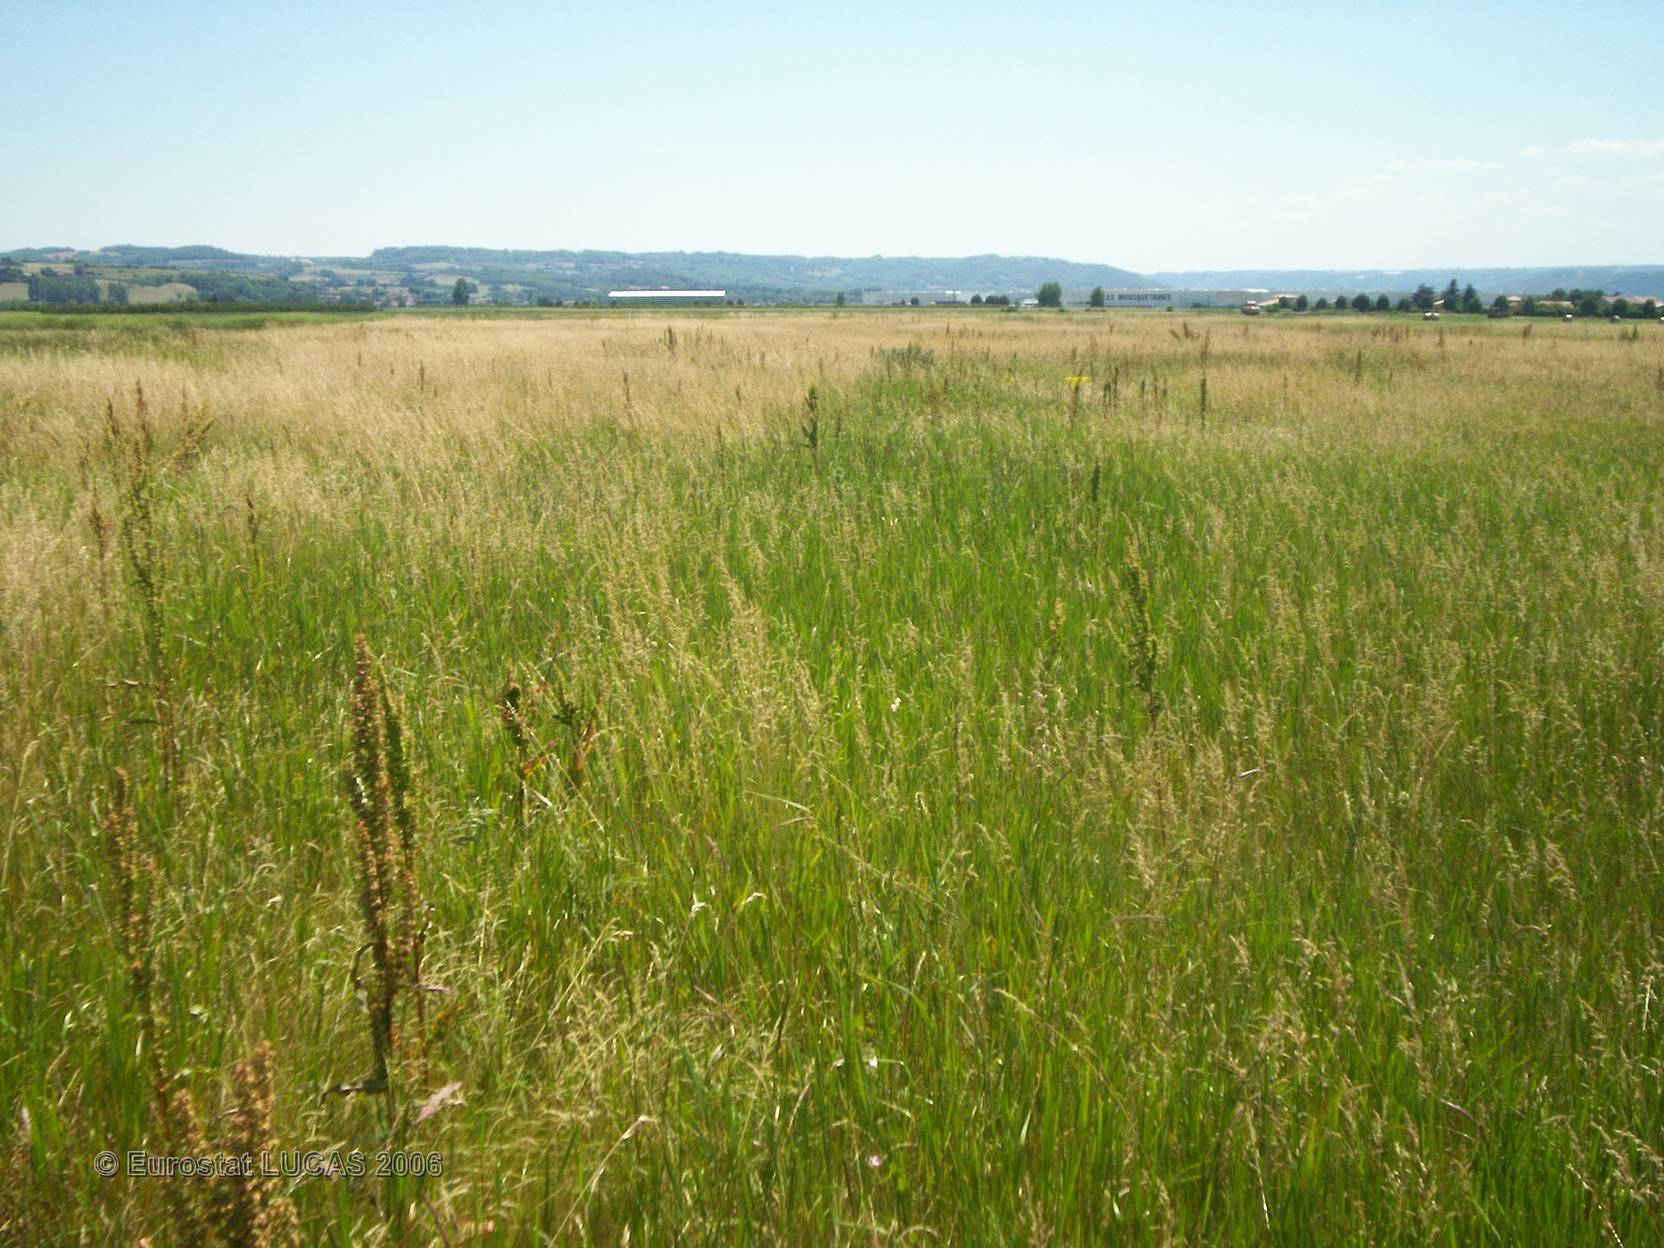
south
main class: Grassland
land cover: Grassland without tree/shrub cover
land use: Agriculture (excluding fallow land and kitchen gardens)
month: June
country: FR
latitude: 45.2700
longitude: 4.8427
